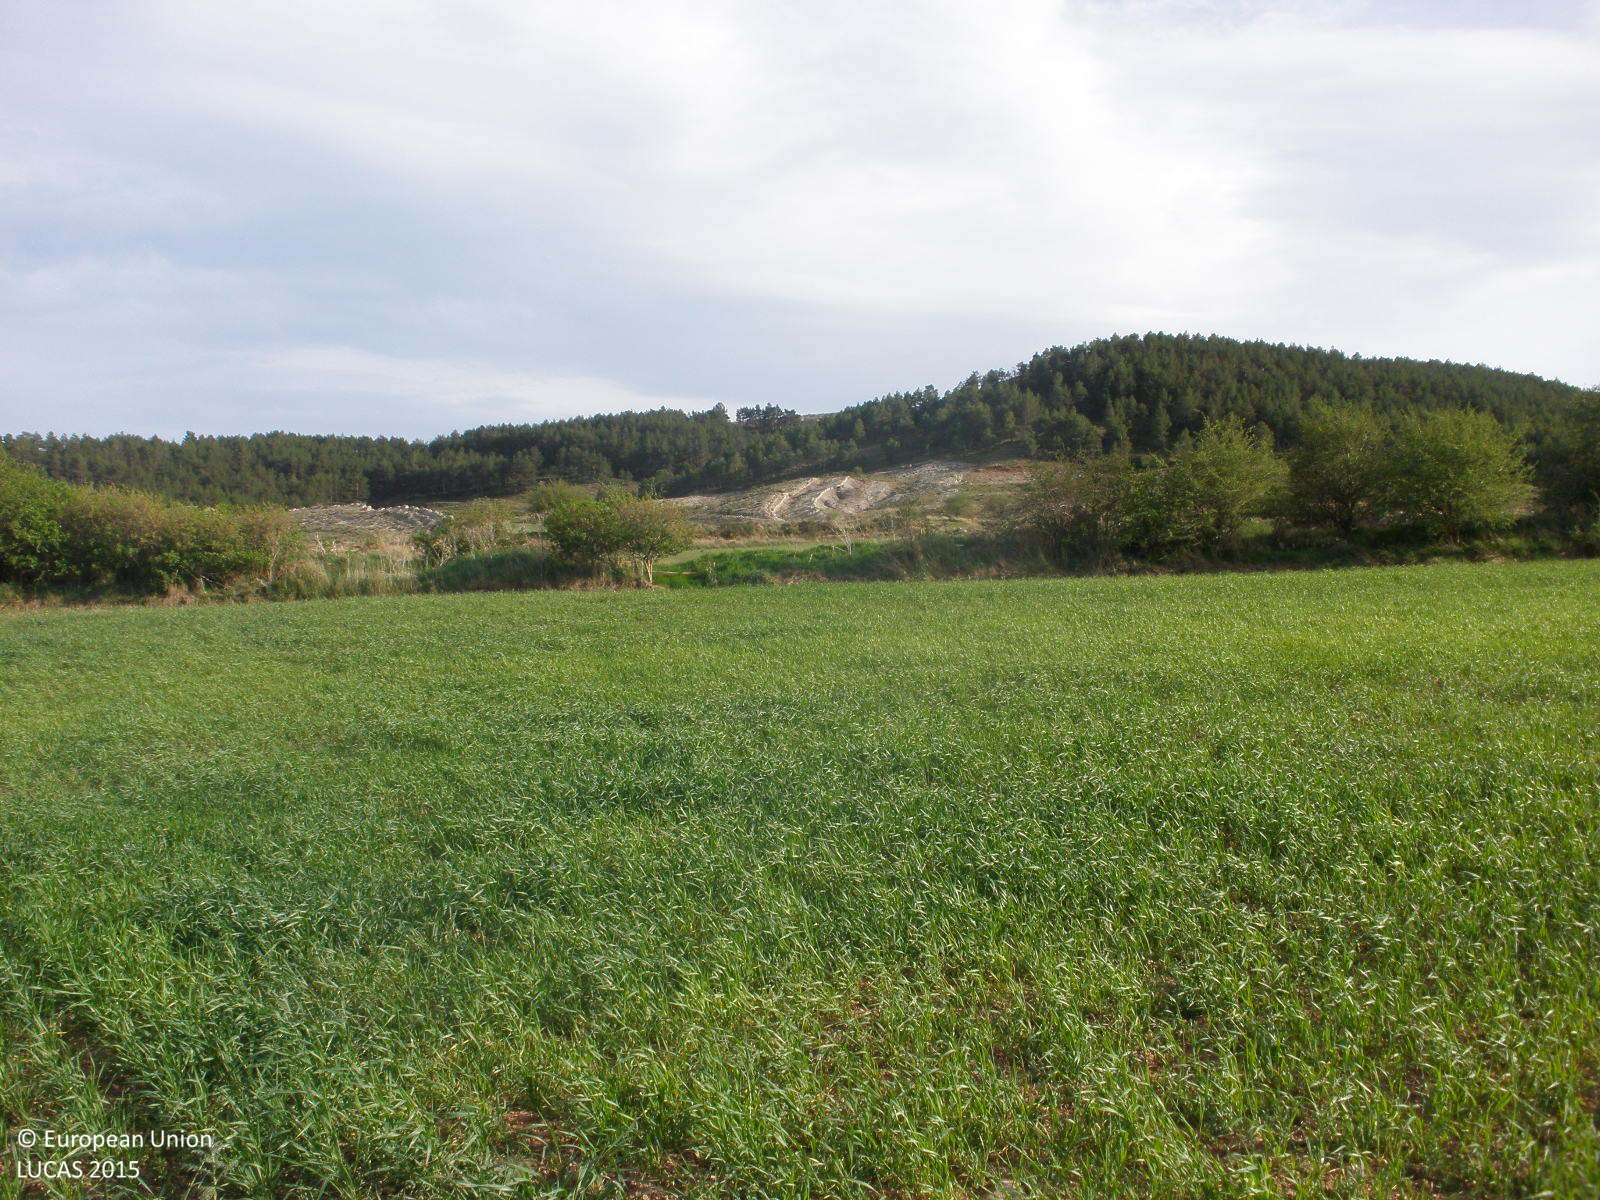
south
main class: Cropland
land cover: Common wheat
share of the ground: > 75 %
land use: Agriculture (excluding fallow land and kitchen gardens)
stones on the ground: 10 - 25 %
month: May
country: ES
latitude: 40.6172
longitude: -0.8033
